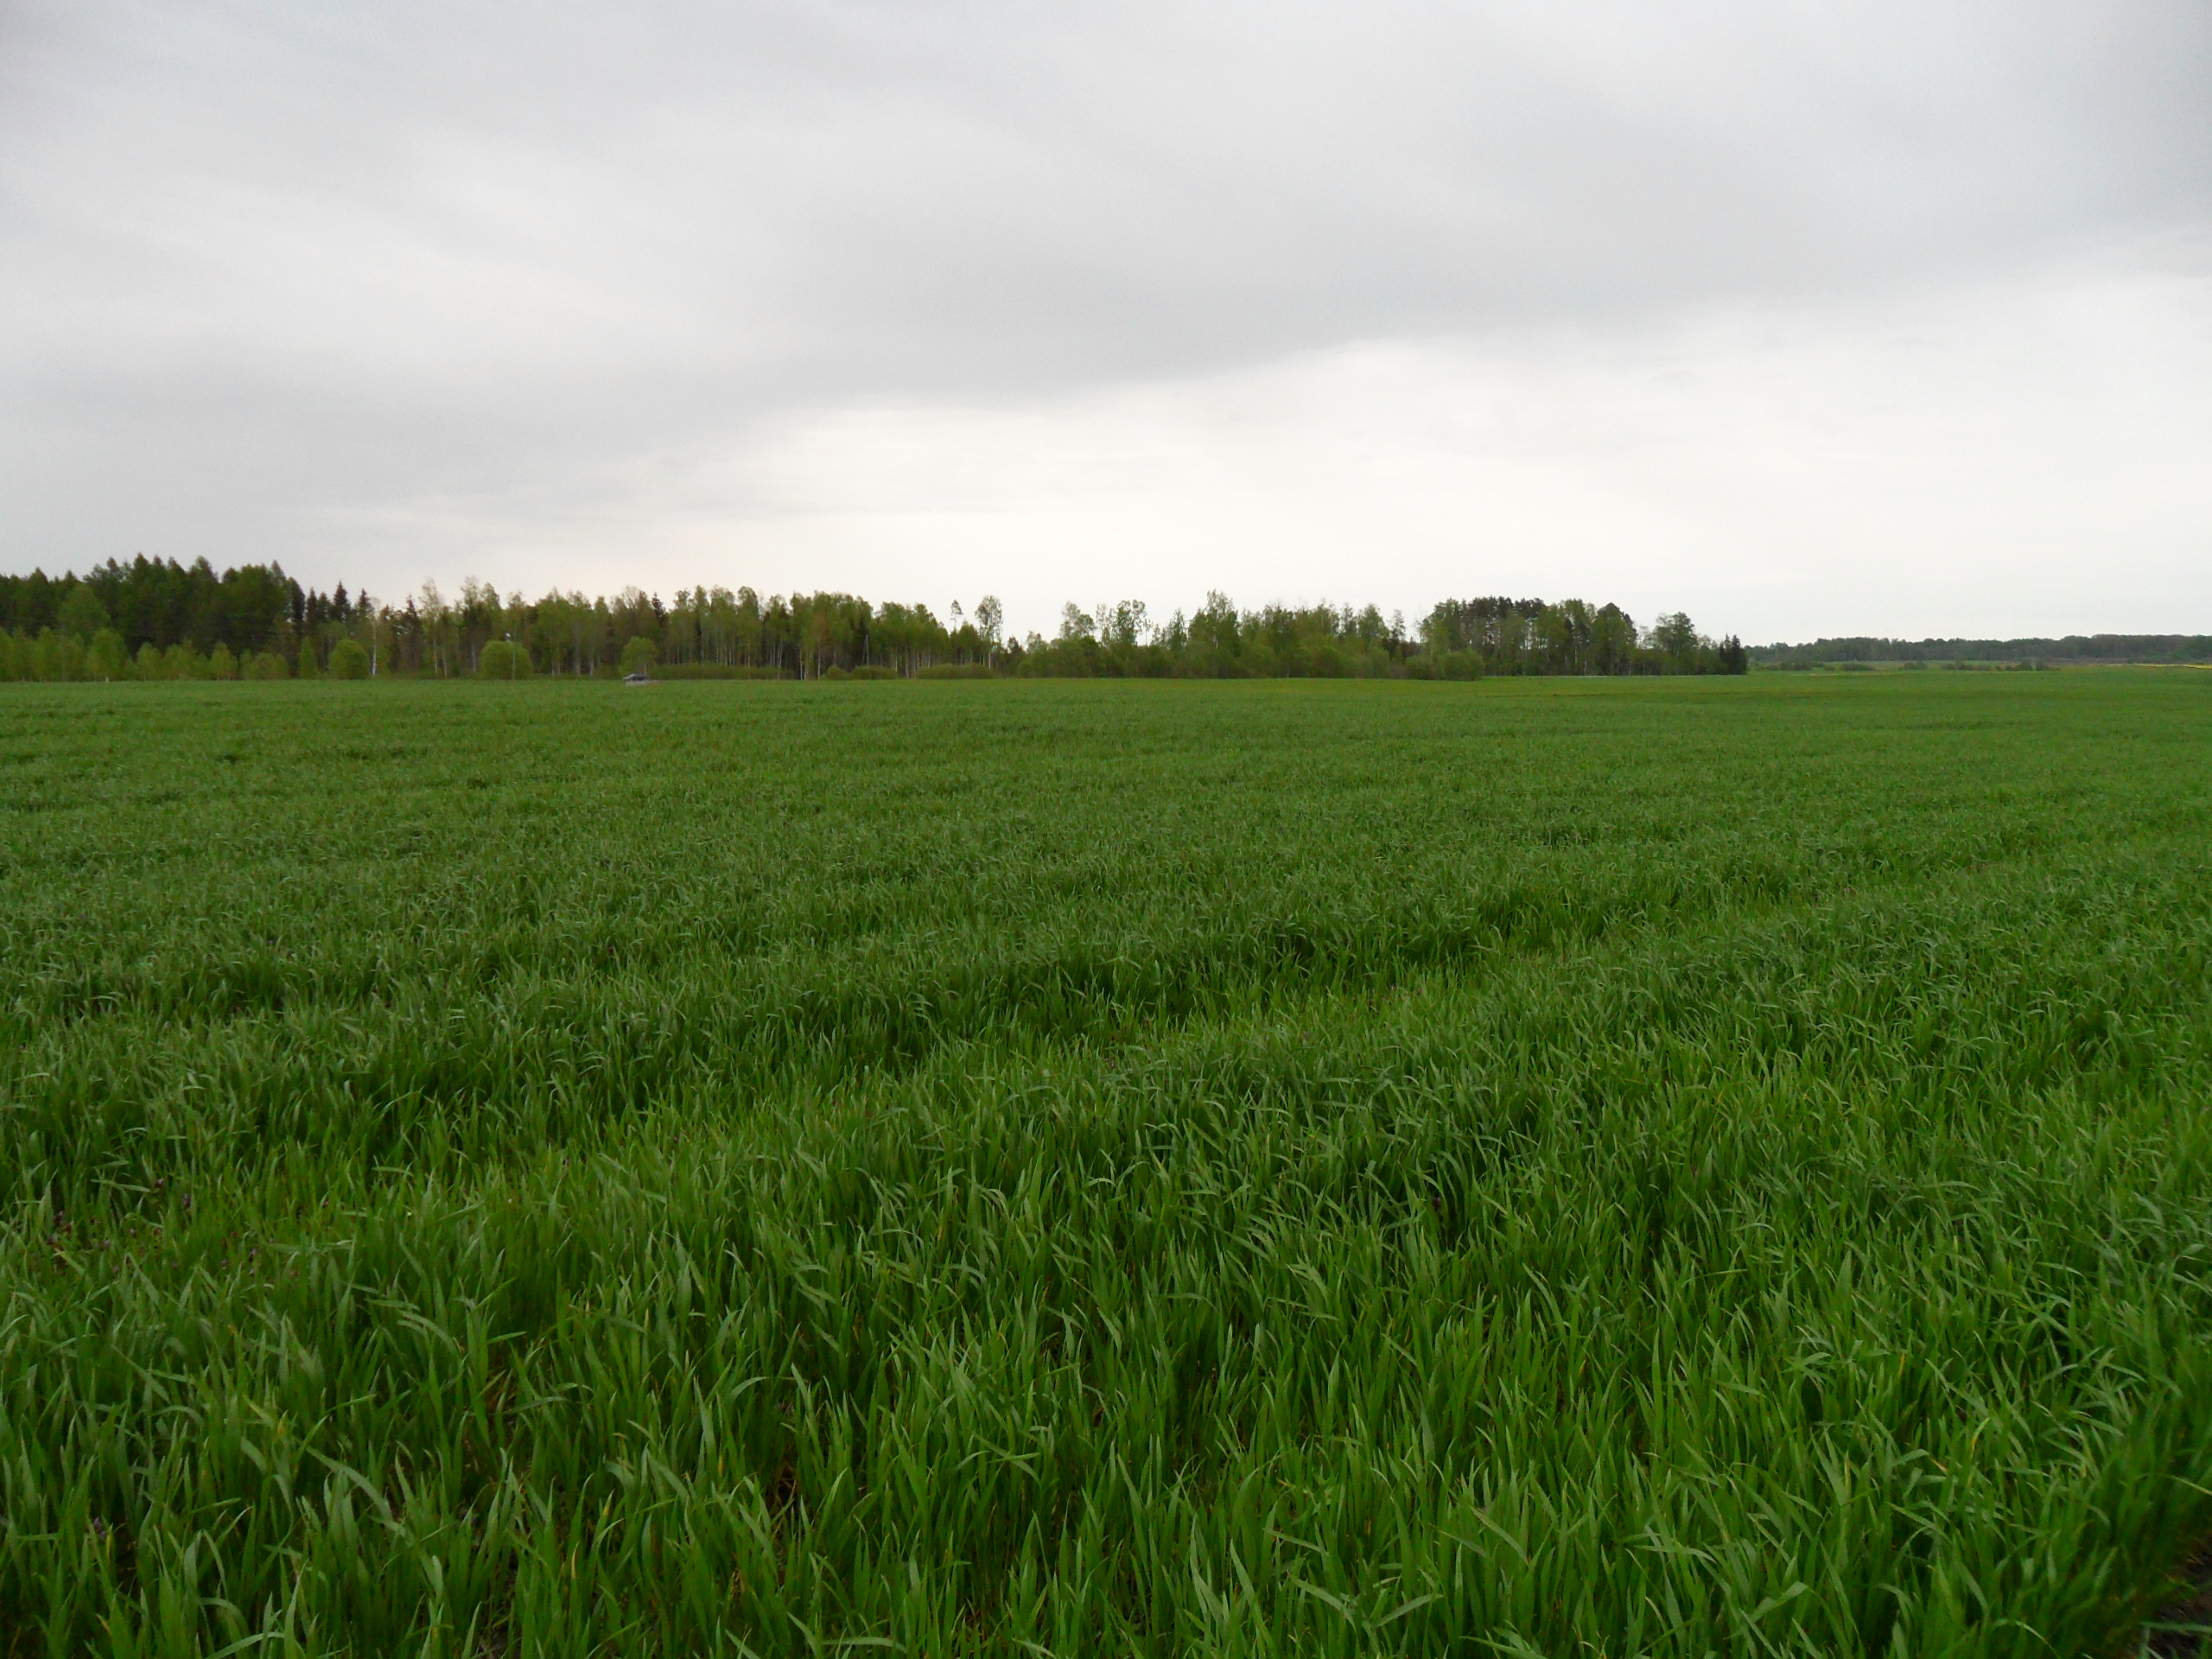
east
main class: Cropland
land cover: Common wheat
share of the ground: > 75 %
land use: Agriculture (excluding fallow land and kitchen gardens)
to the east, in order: Common wheat; Grassland without tree/shrub cover
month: May
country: LV
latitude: 57.2999
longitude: 22.5517
